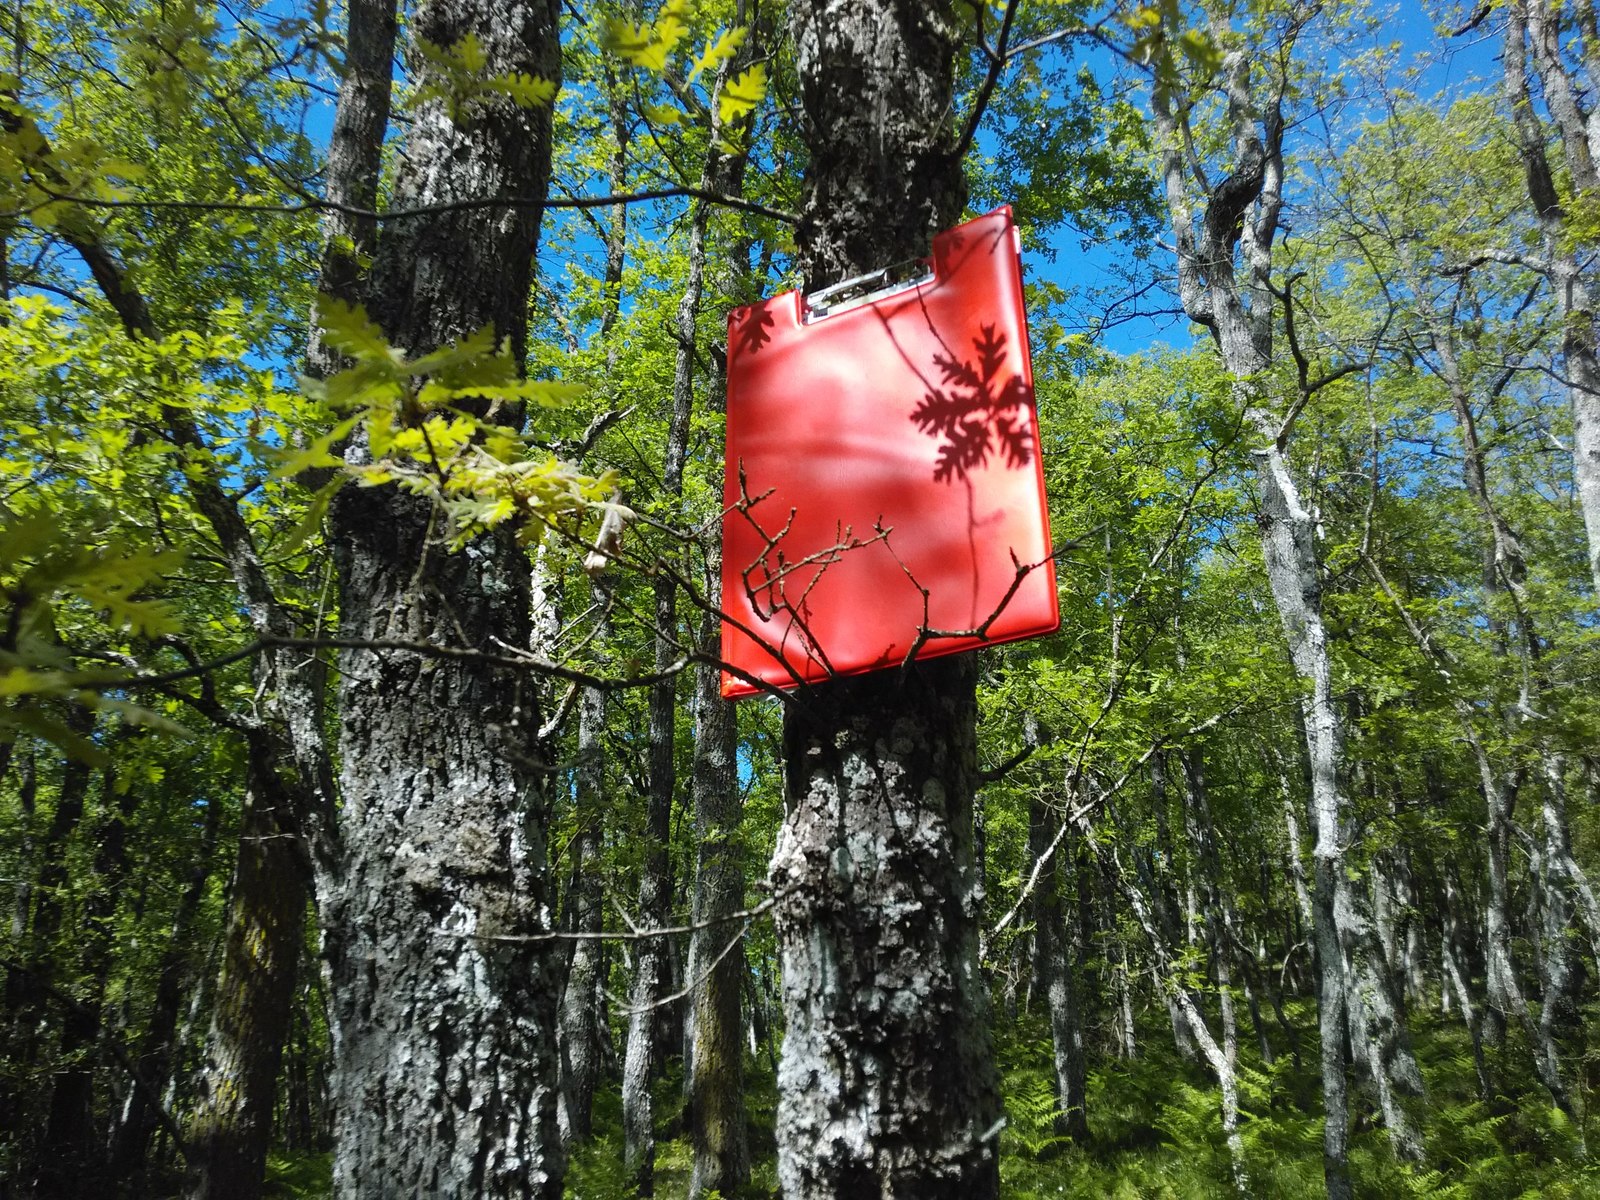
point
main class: Woodland
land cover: Broadleaved woodland
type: acidophilous oak and oak-birch forest
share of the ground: > 75 %
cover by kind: broadleaved forest trees 75 %, shrubs 15 %, herbaceous plants 10 %
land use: Forestry
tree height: > 5 m
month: May
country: ES
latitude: 42.6637
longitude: -2.4793
